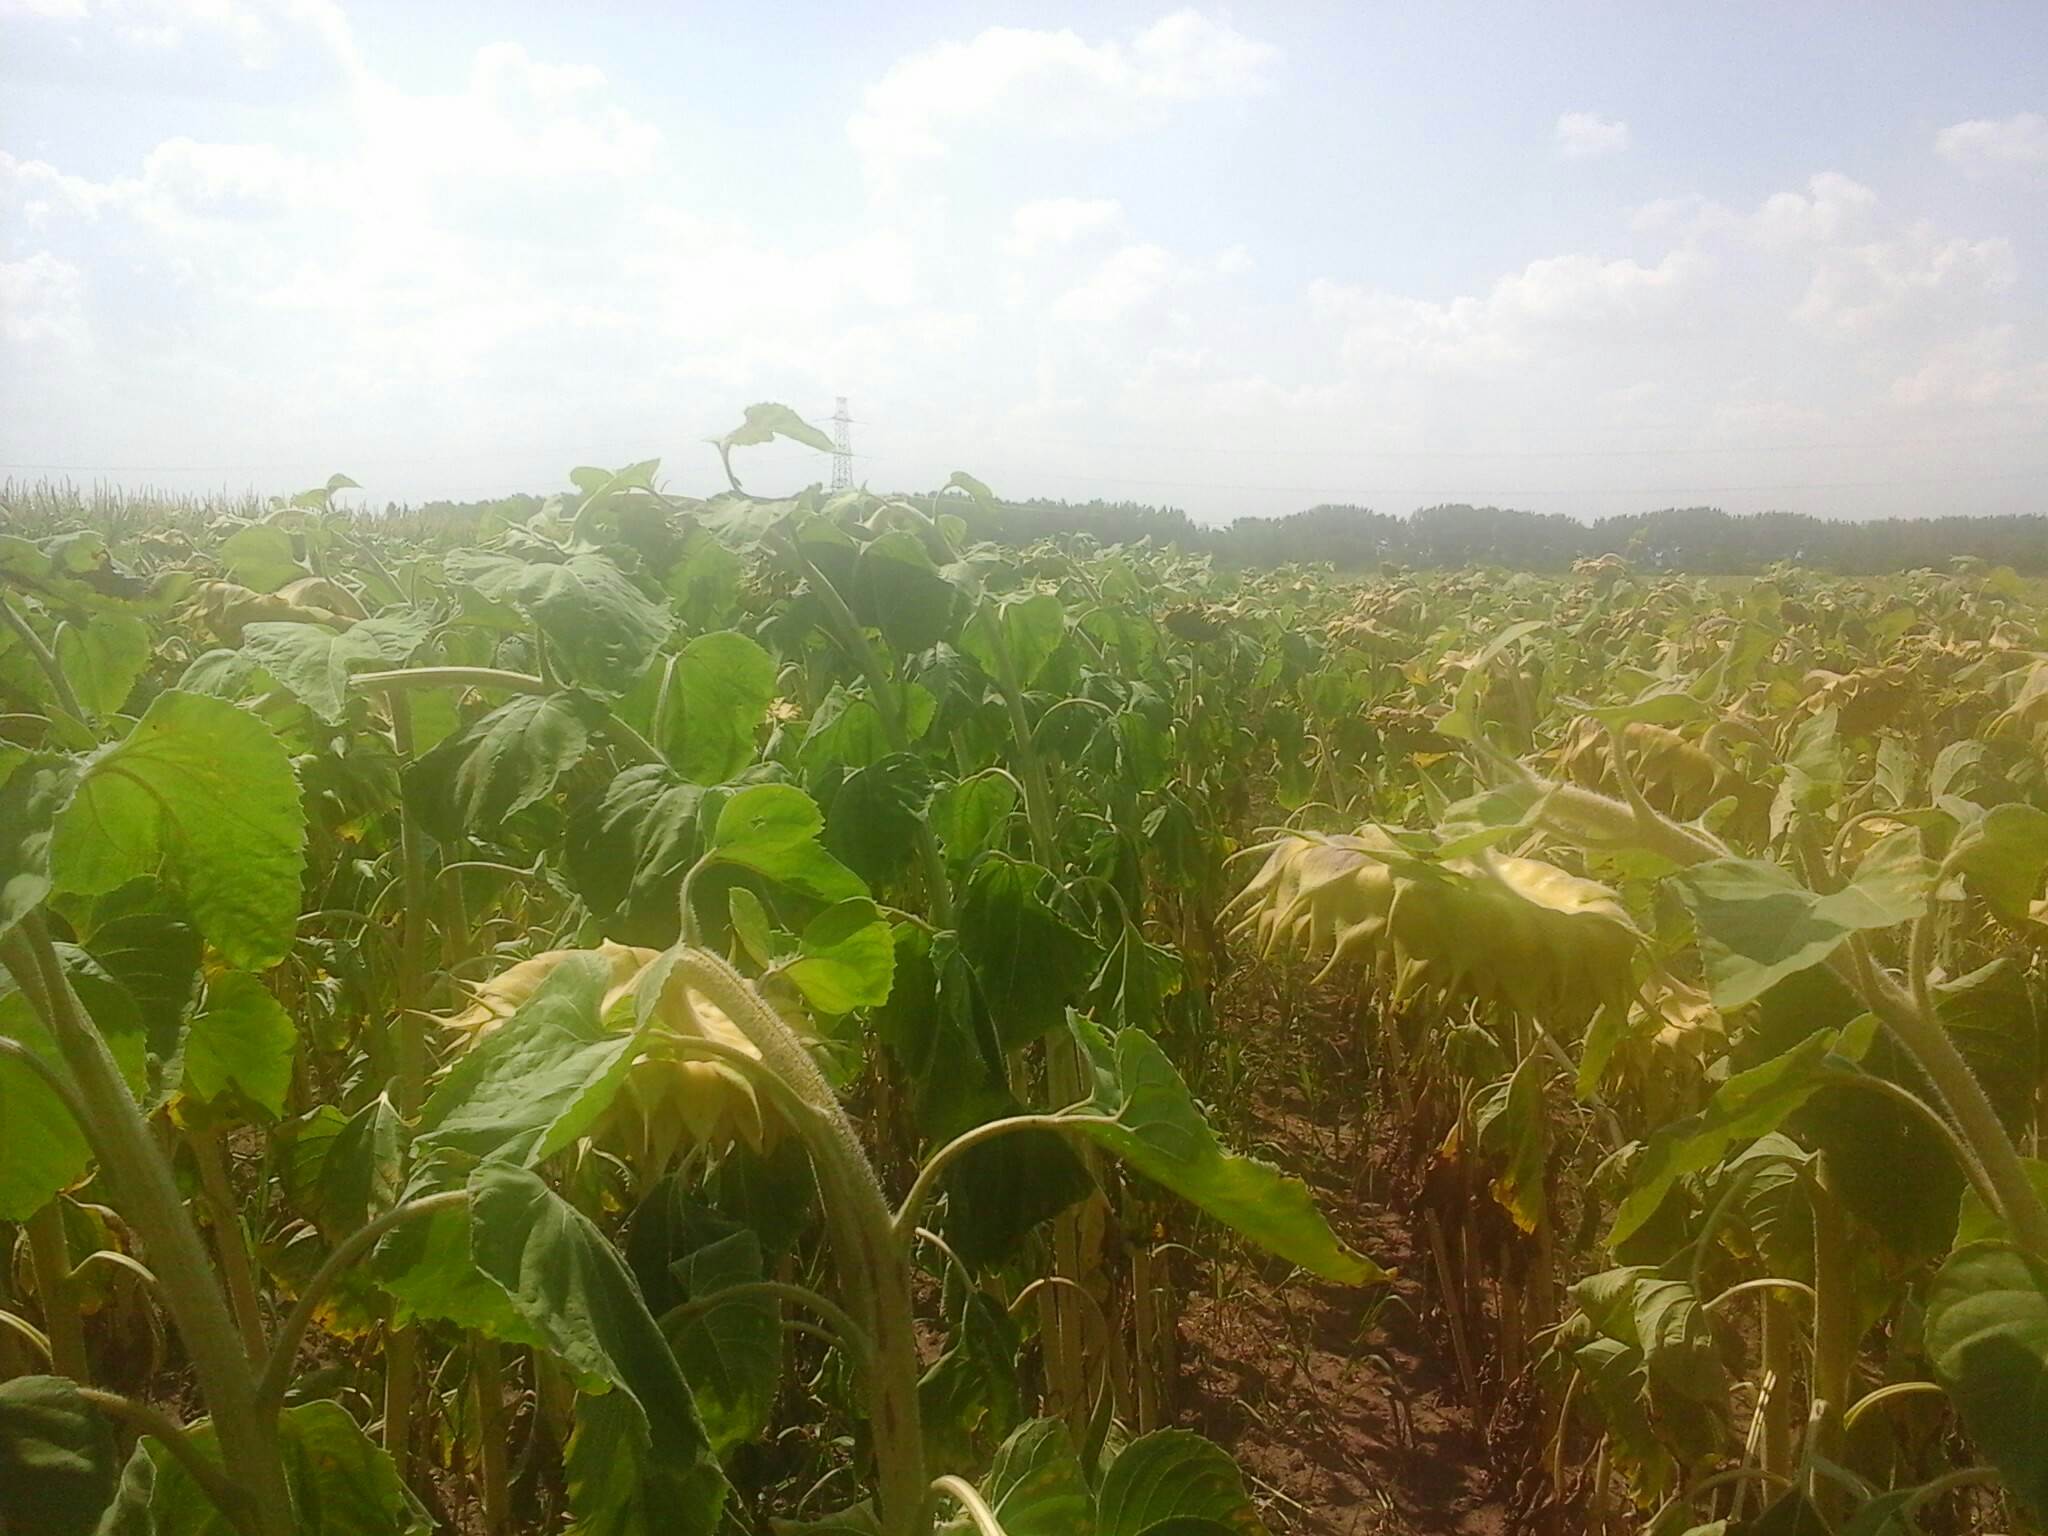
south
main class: Cropland
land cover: Sunflower
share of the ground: > 75 %
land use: Agriculture (excluding fallow land and kitchen gardens)
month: August
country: HU
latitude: 47.5907
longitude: 17.9764
